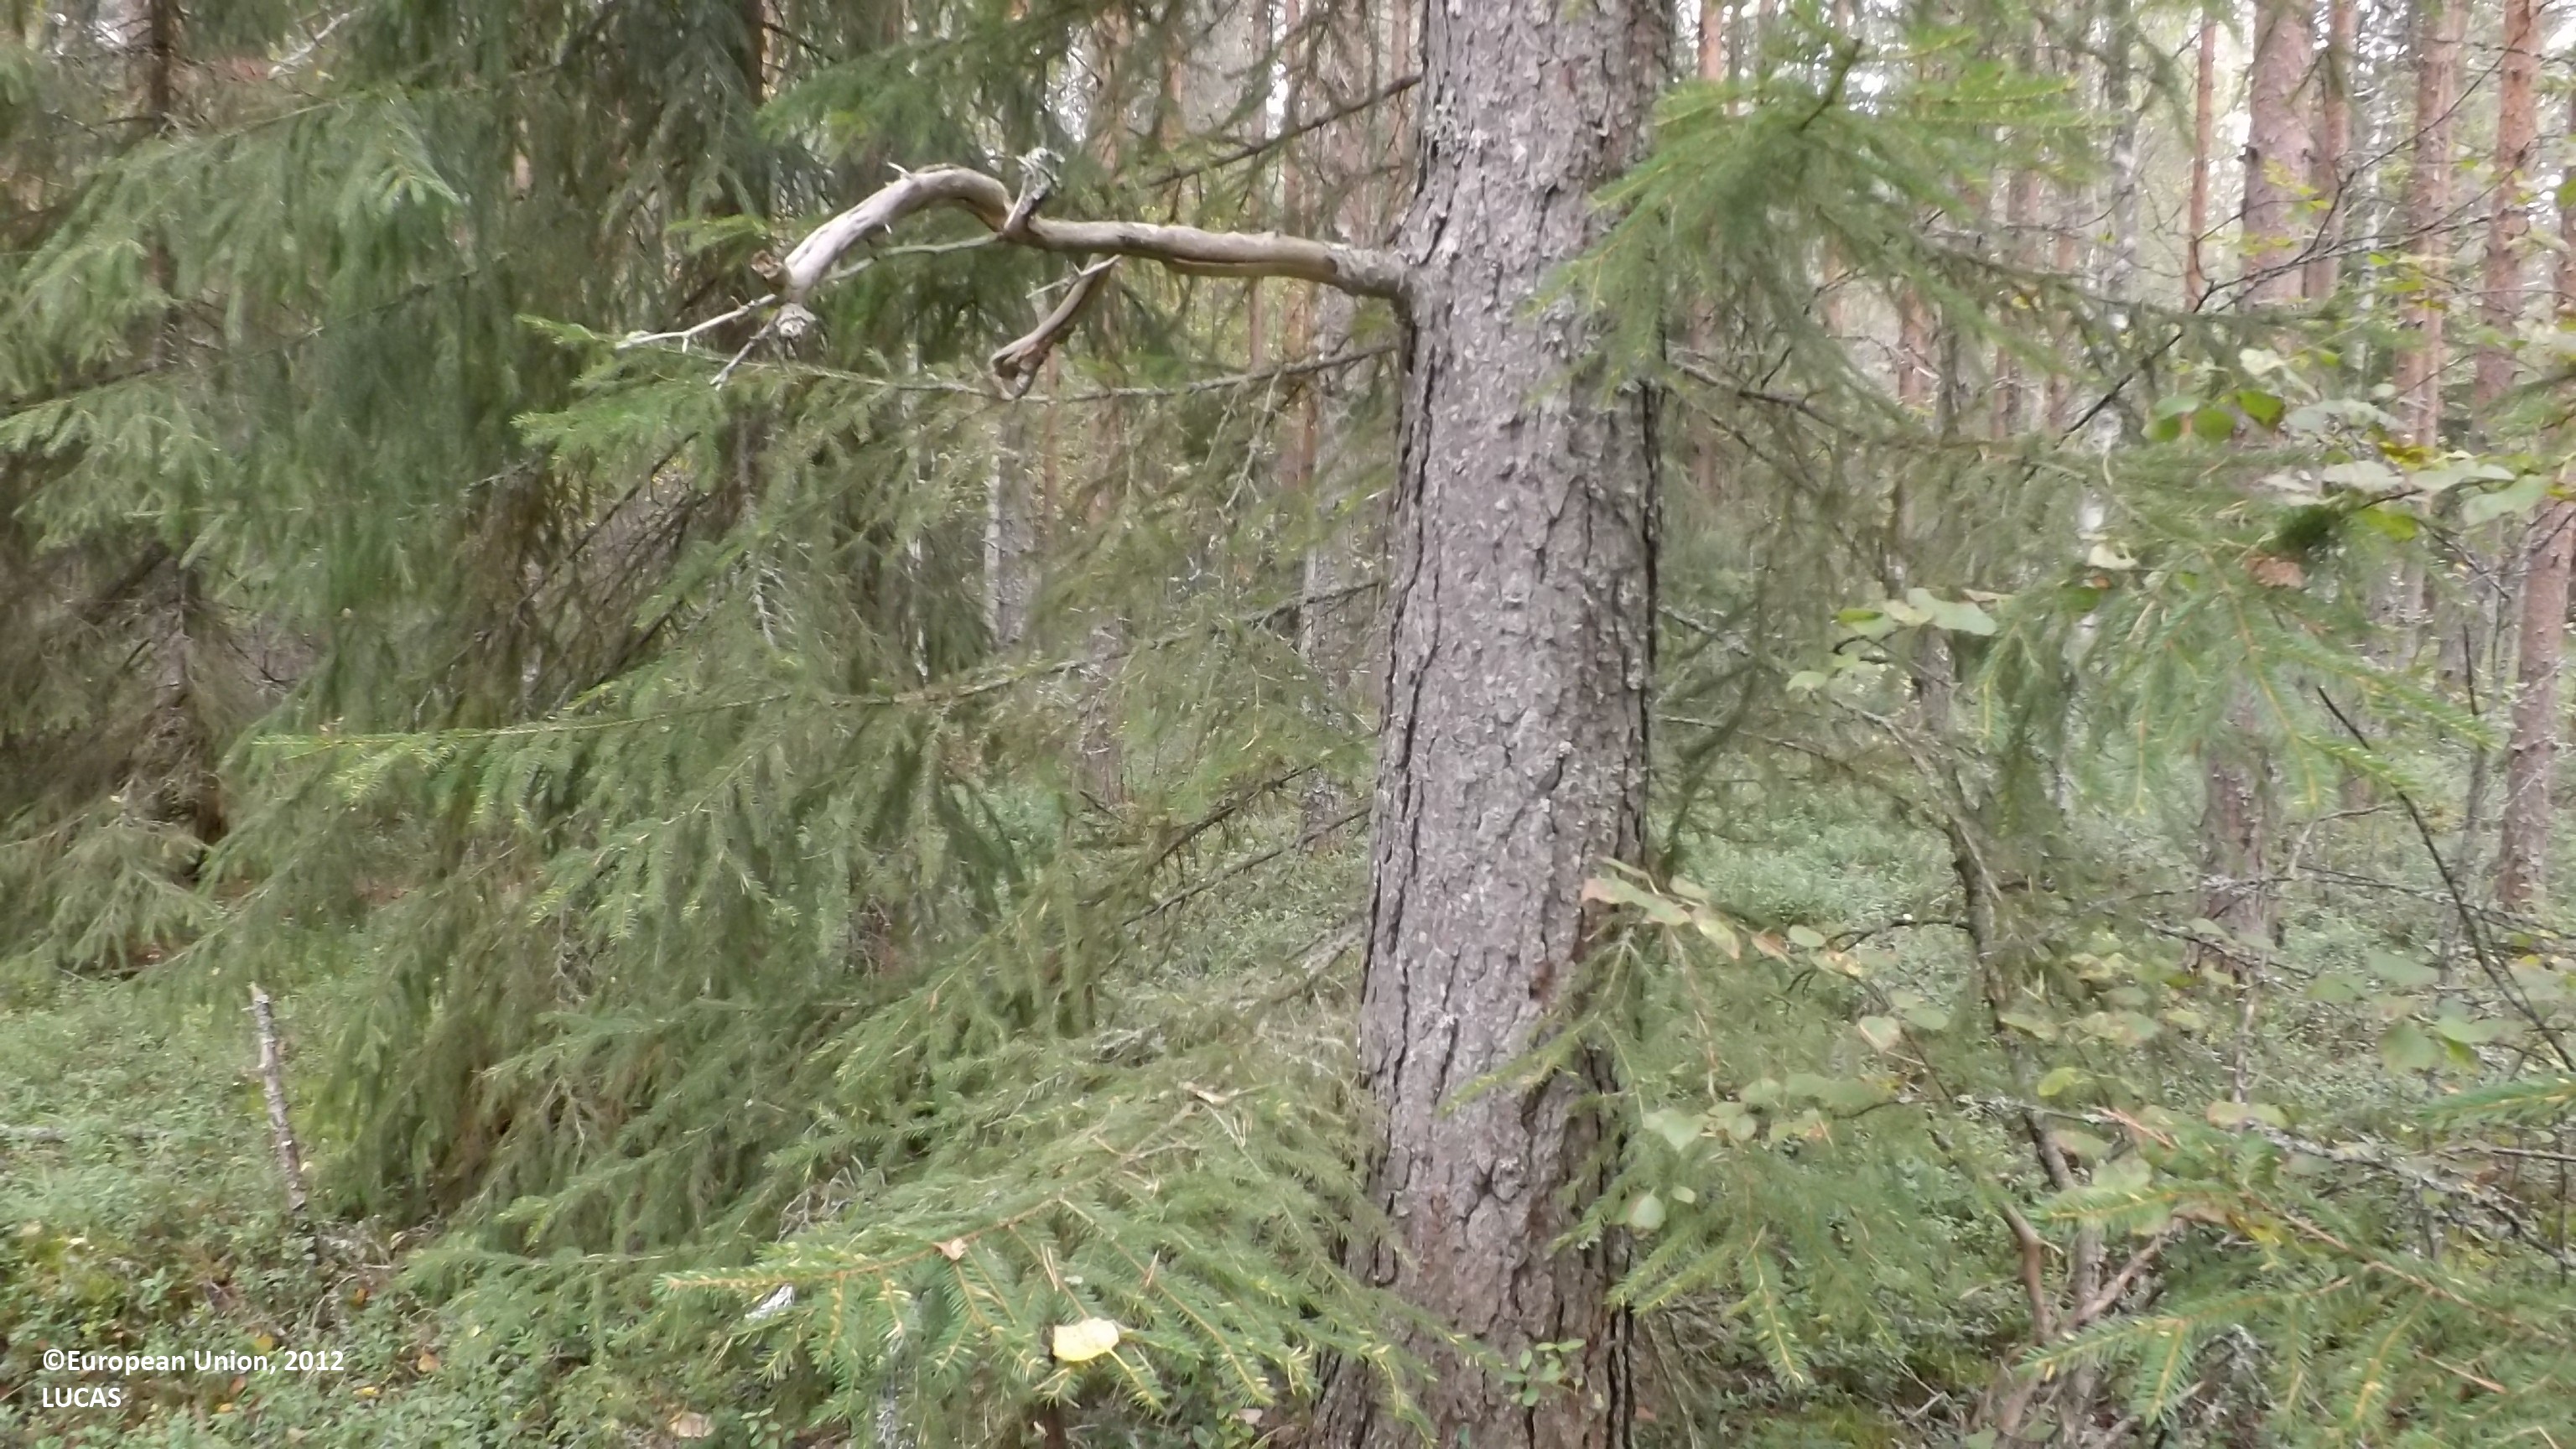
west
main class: Woodland
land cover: Pine dominated mixed woodland
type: boreal forest
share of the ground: 50 - 75 %
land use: Forestry
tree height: > 5 m
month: August
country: FI
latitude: 63.8967
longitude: 24.0623
